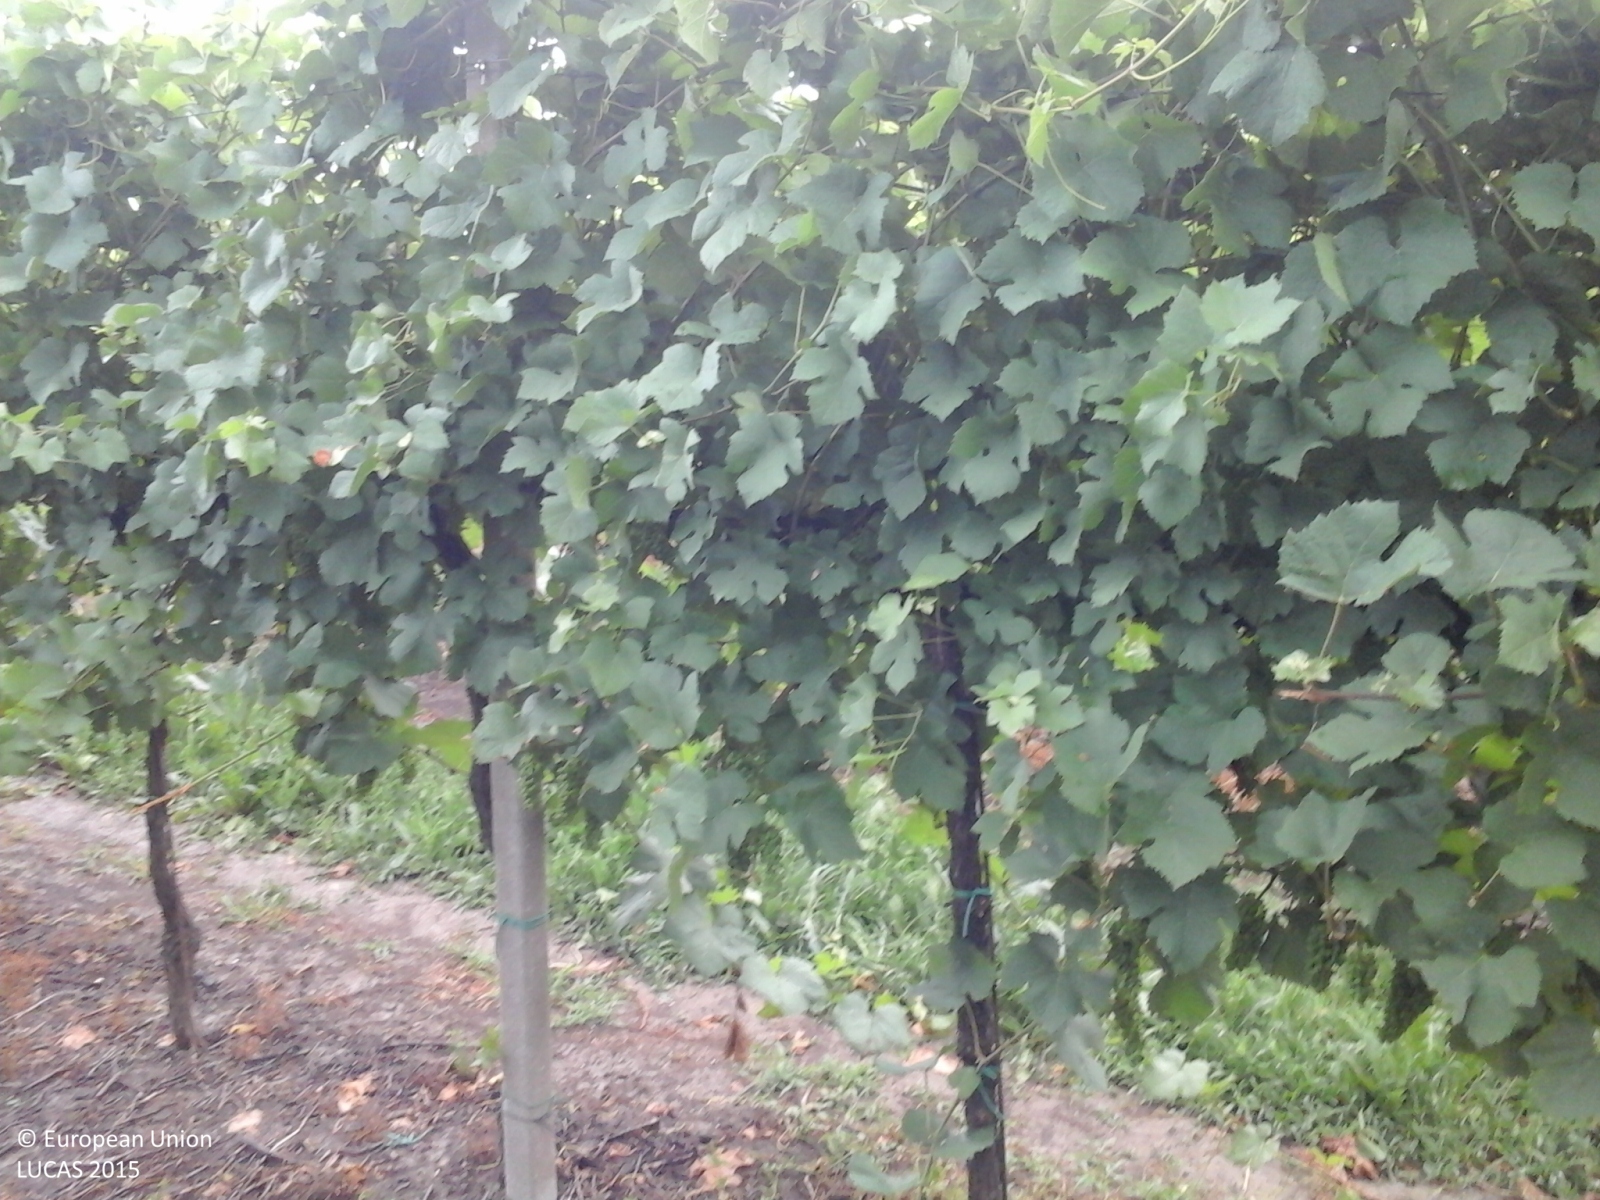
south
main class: Cropland
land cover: Vineyards
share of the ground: 25 - 50 %
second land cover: Grassland without tree/shrub cover
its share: 50 - 75 %
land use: Agriculture (excluding fallow land and kitchen gardens)
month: June
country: IT
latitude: 45.6141
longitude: 12.7019
